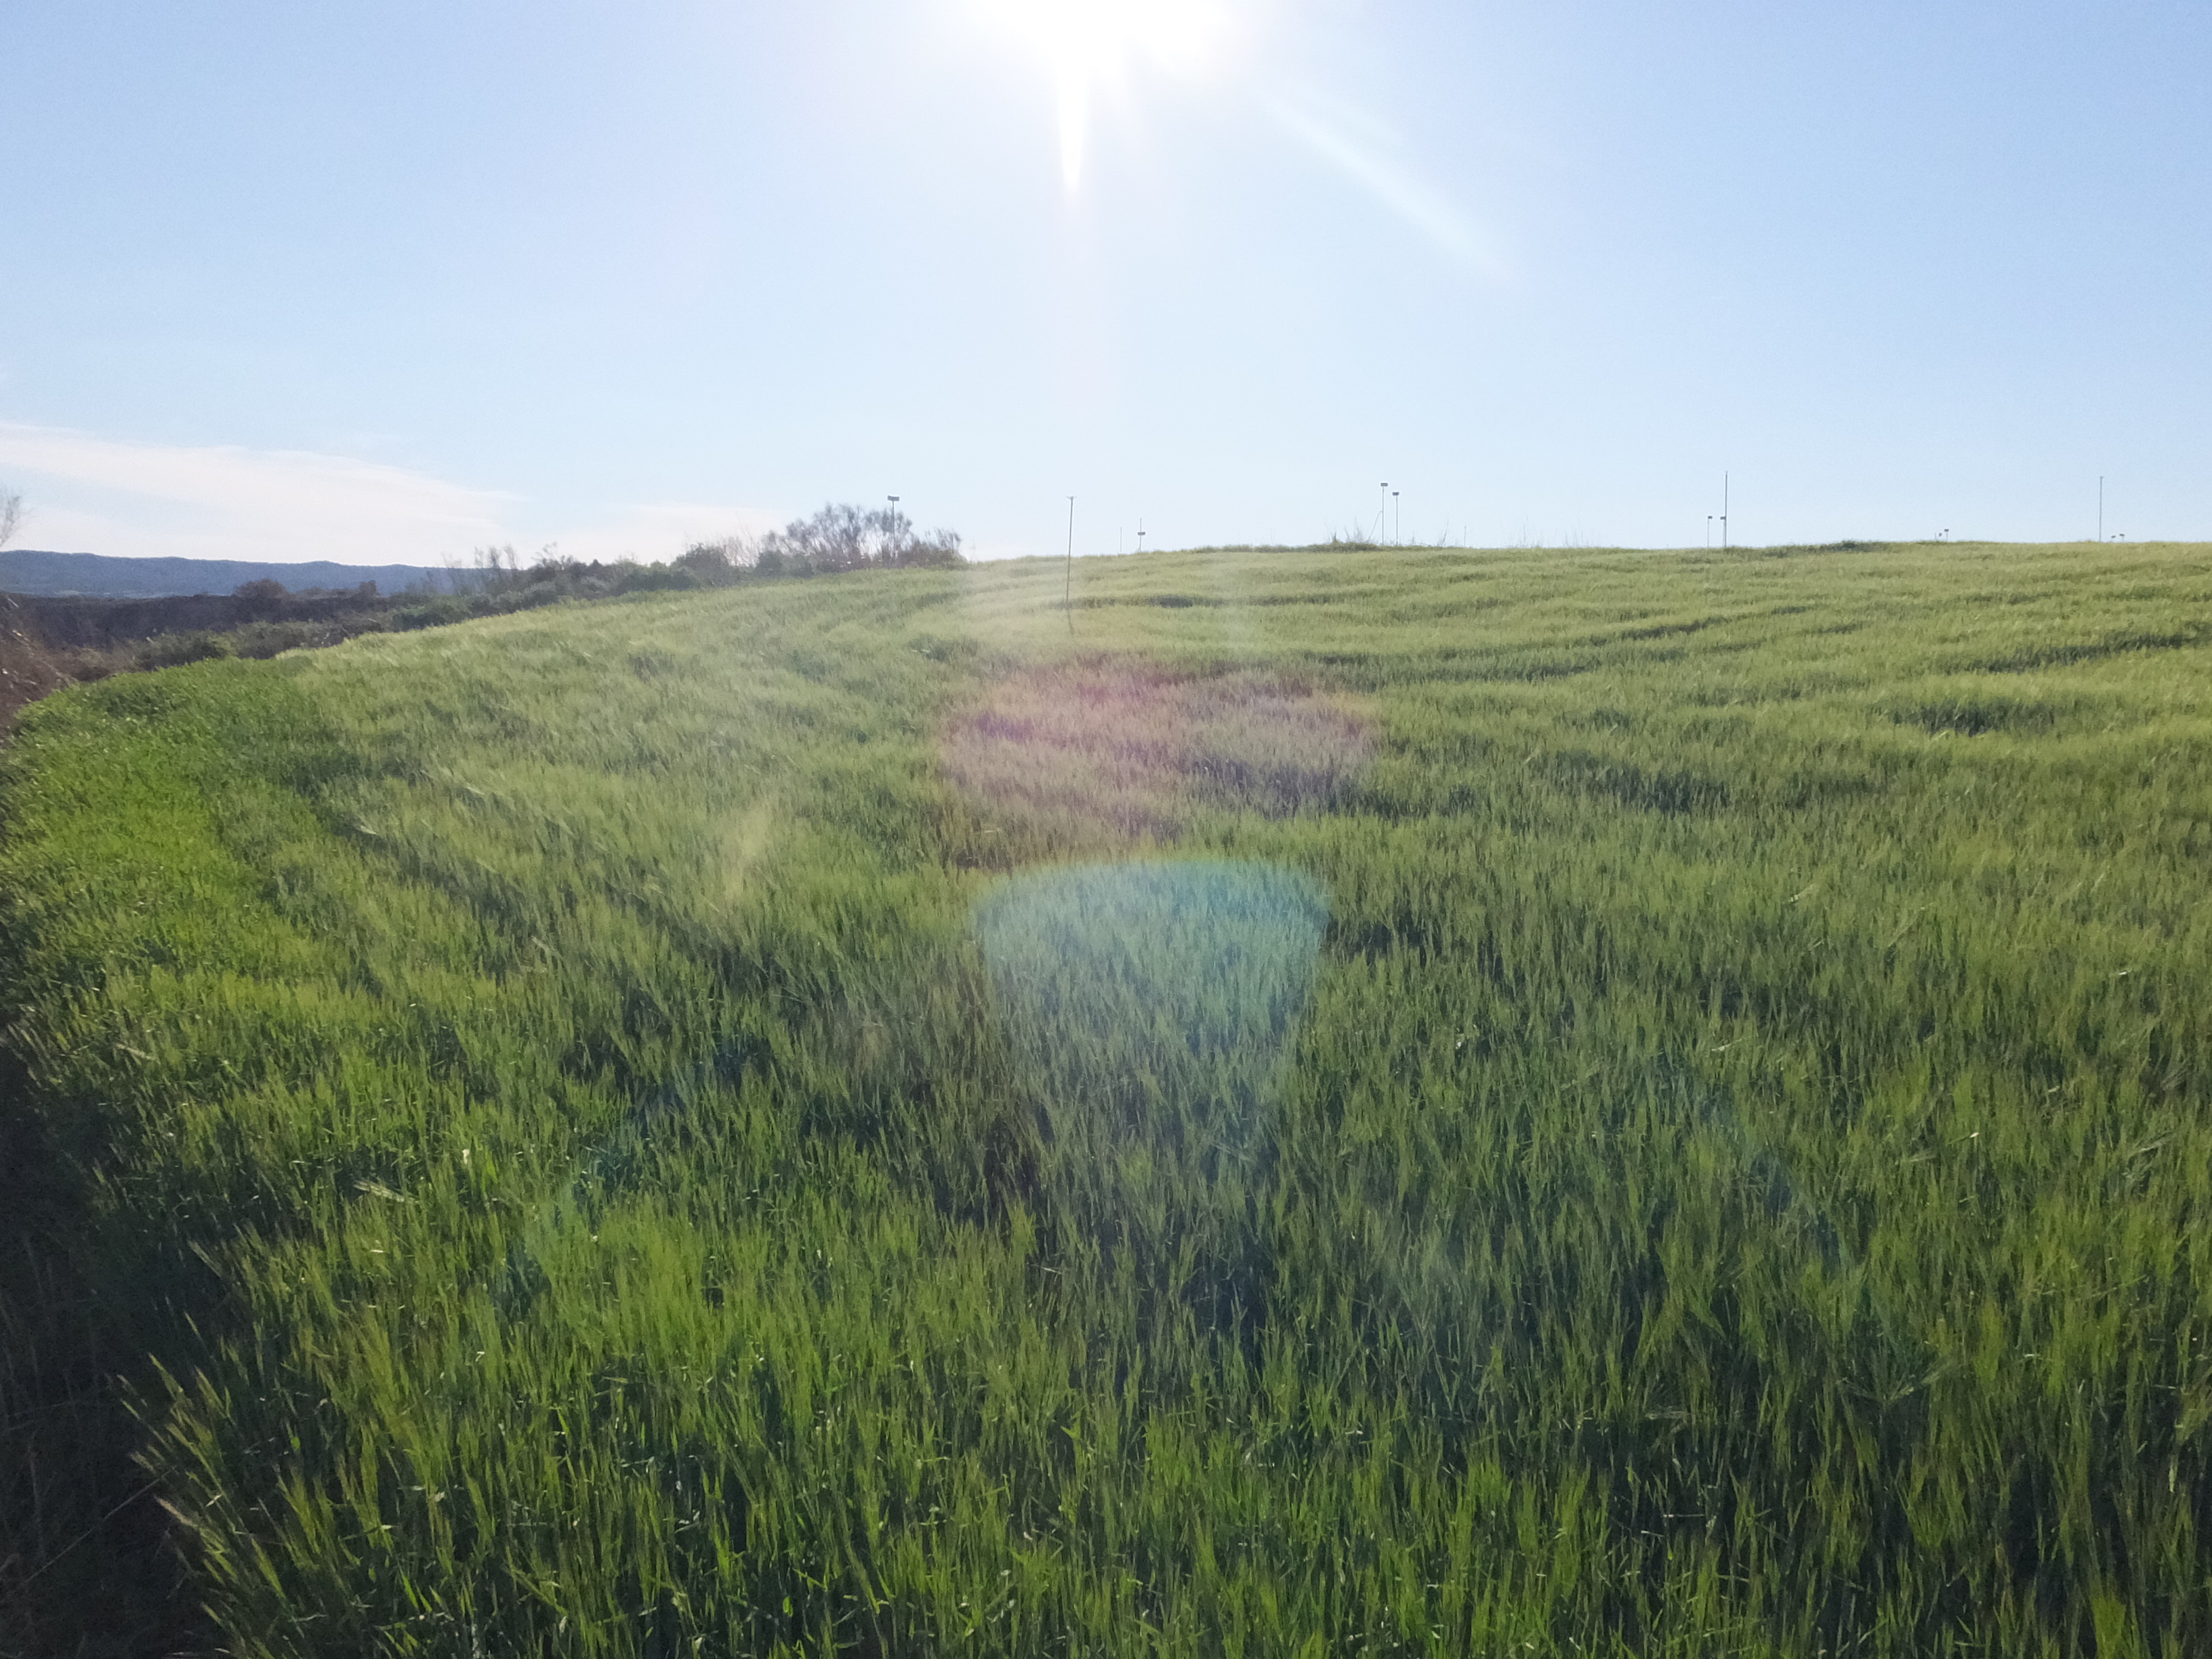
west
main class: Grassland
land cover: Grassland with sparse tree/shrub cover
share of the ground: > 75 %
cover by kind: herbaceous plants 90 %, coniferous forest trees 5 %, shrubs 5 %
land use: Semi-natural and natural areas not in use
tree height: < 5 m
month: April
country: ES
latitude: 41.7016
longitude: -0.1957
